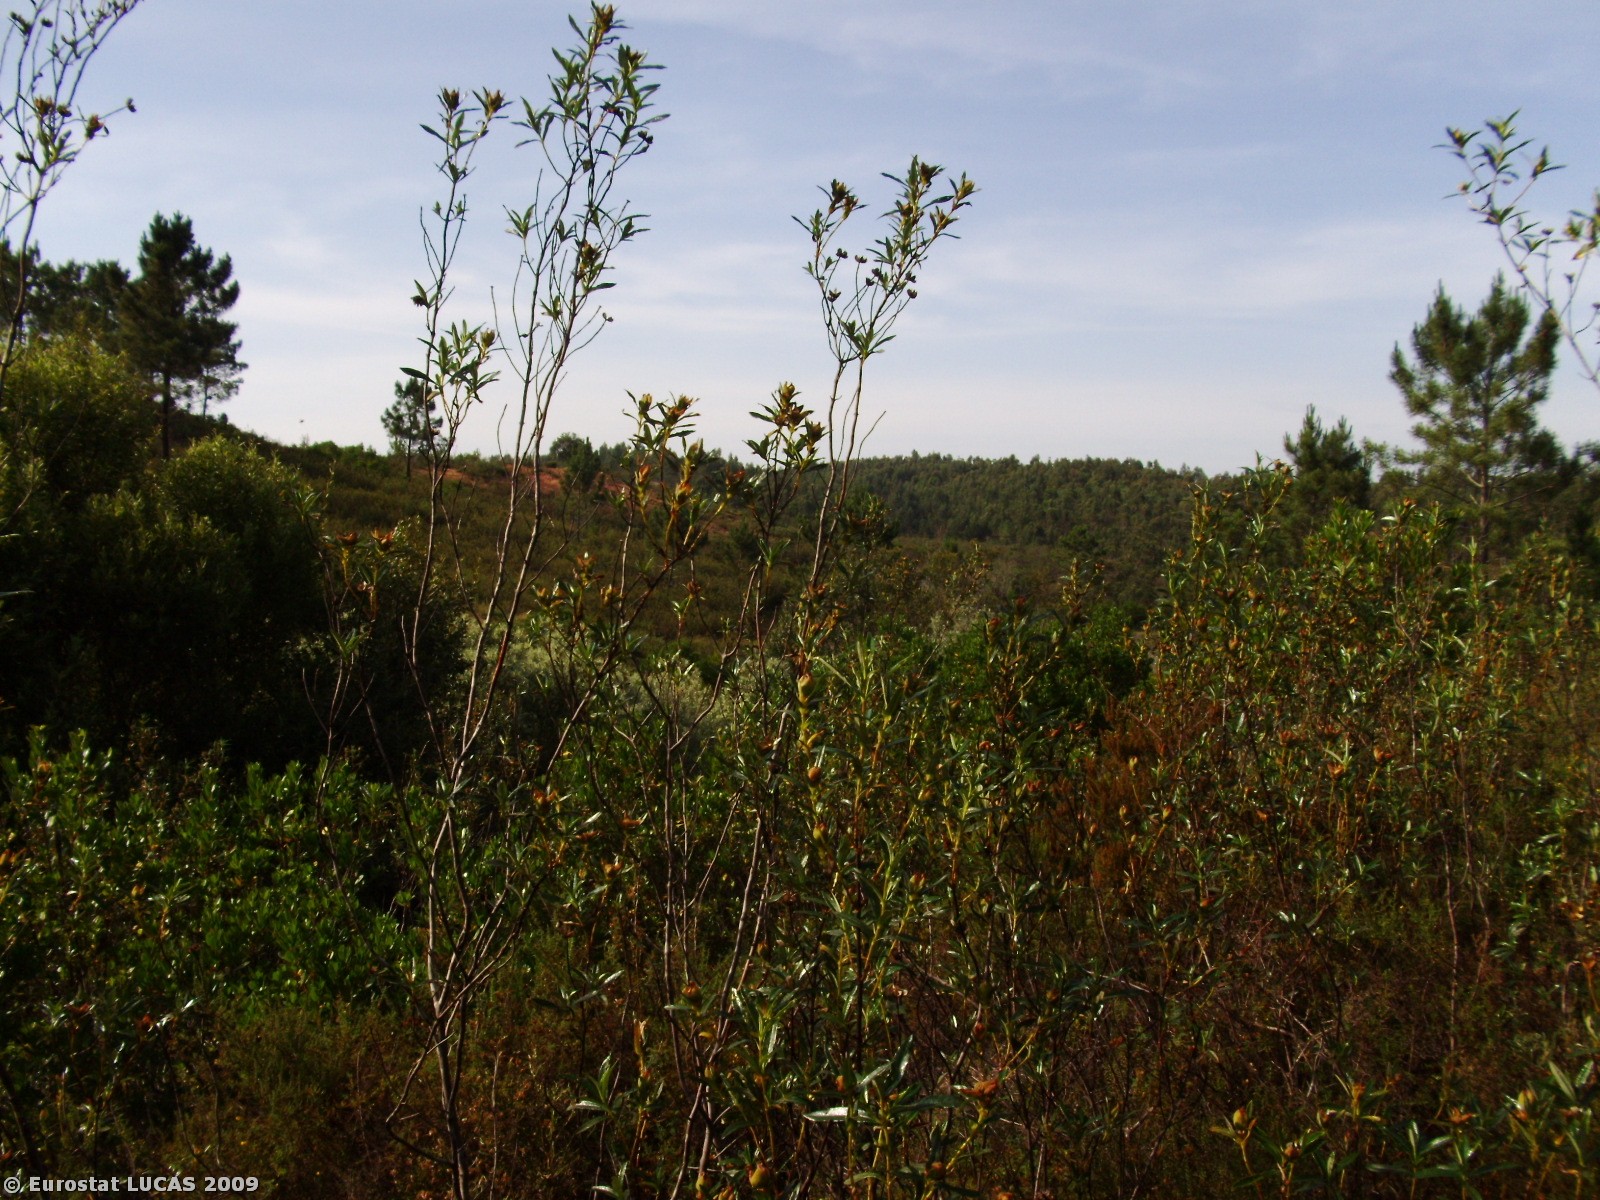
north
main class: Shrubland
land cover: Shrubland without tree cover
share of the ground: > 75 %
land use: Unused
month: June
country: PT
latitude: 37.3850
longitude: -8.7508
